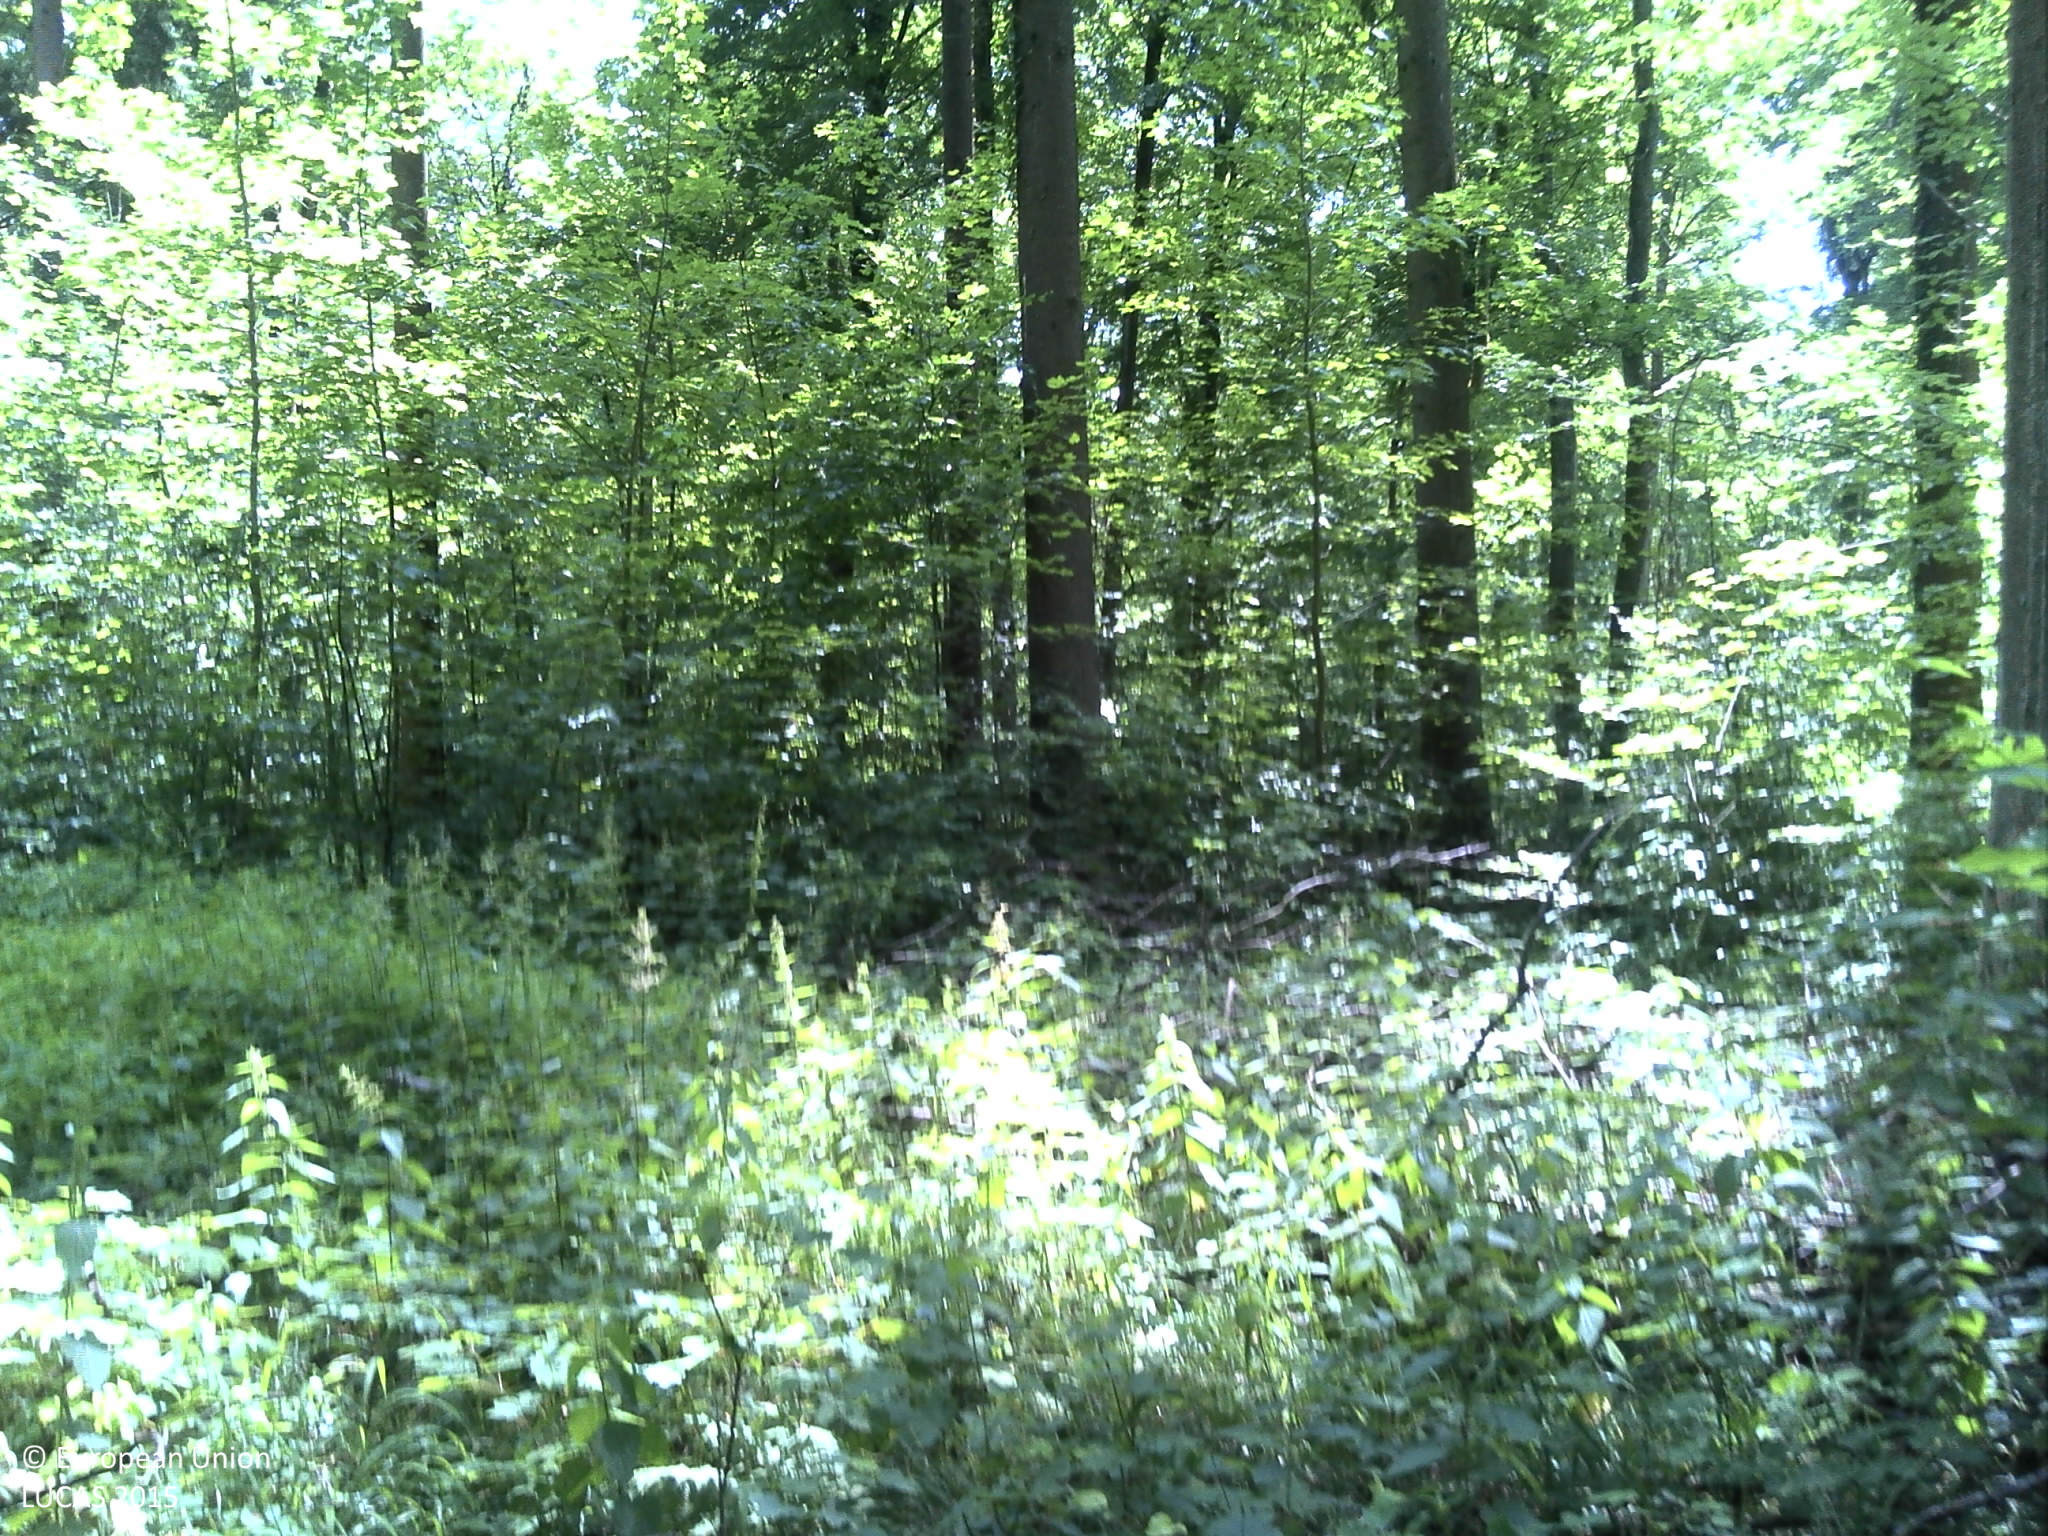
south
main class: Woodland
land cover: Broadleaved woodland
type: beech forest
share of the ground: > 75 %
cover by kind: broadleaved forest trees 80 %, coniferous forest trees 10 %, herbaceous plants 10 %
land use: Forestry
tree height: > 5 m
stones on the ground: < 10 %
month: June
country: FR
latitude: 49.2877
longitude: 6.0537
